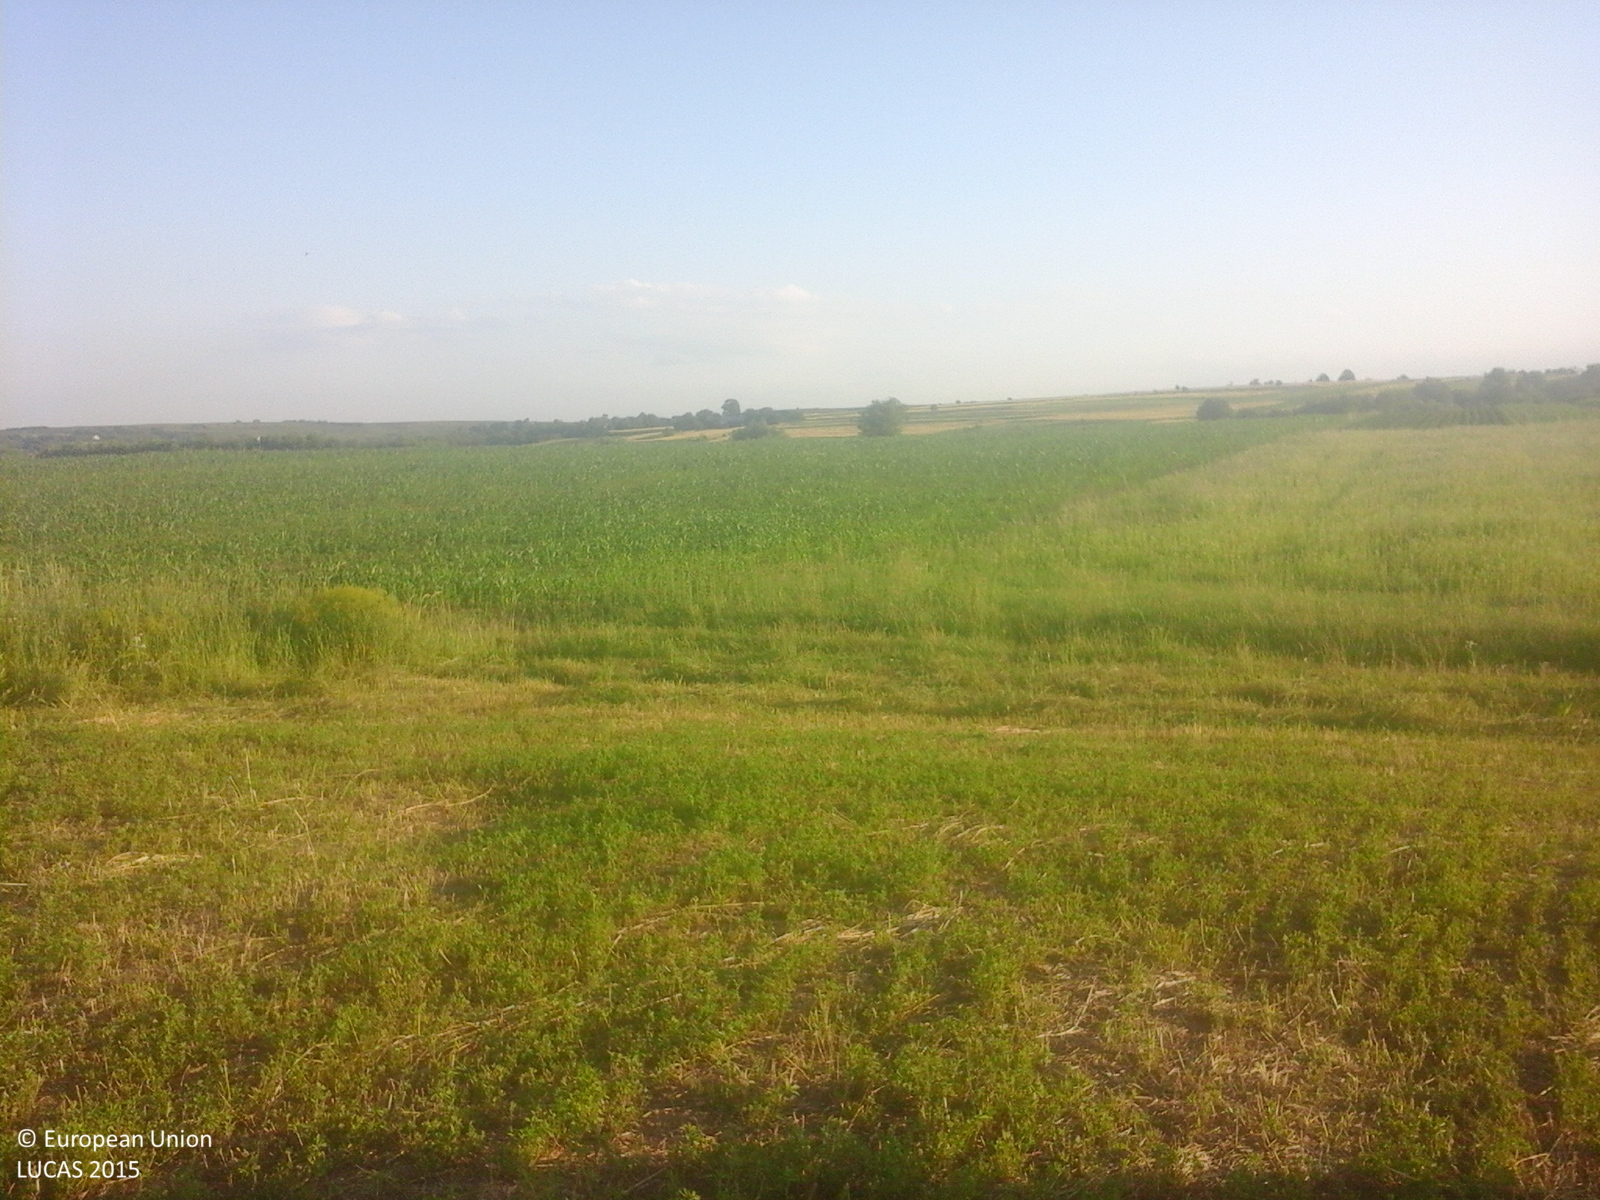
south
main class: Cropland
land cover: Lucerne
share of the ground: 25 - 50 %
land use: Agriculture (excluding fallow land and kitchen gardens)
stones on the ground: < 10 %
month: June
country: RO
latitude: 47.9578
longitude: 26.0285
